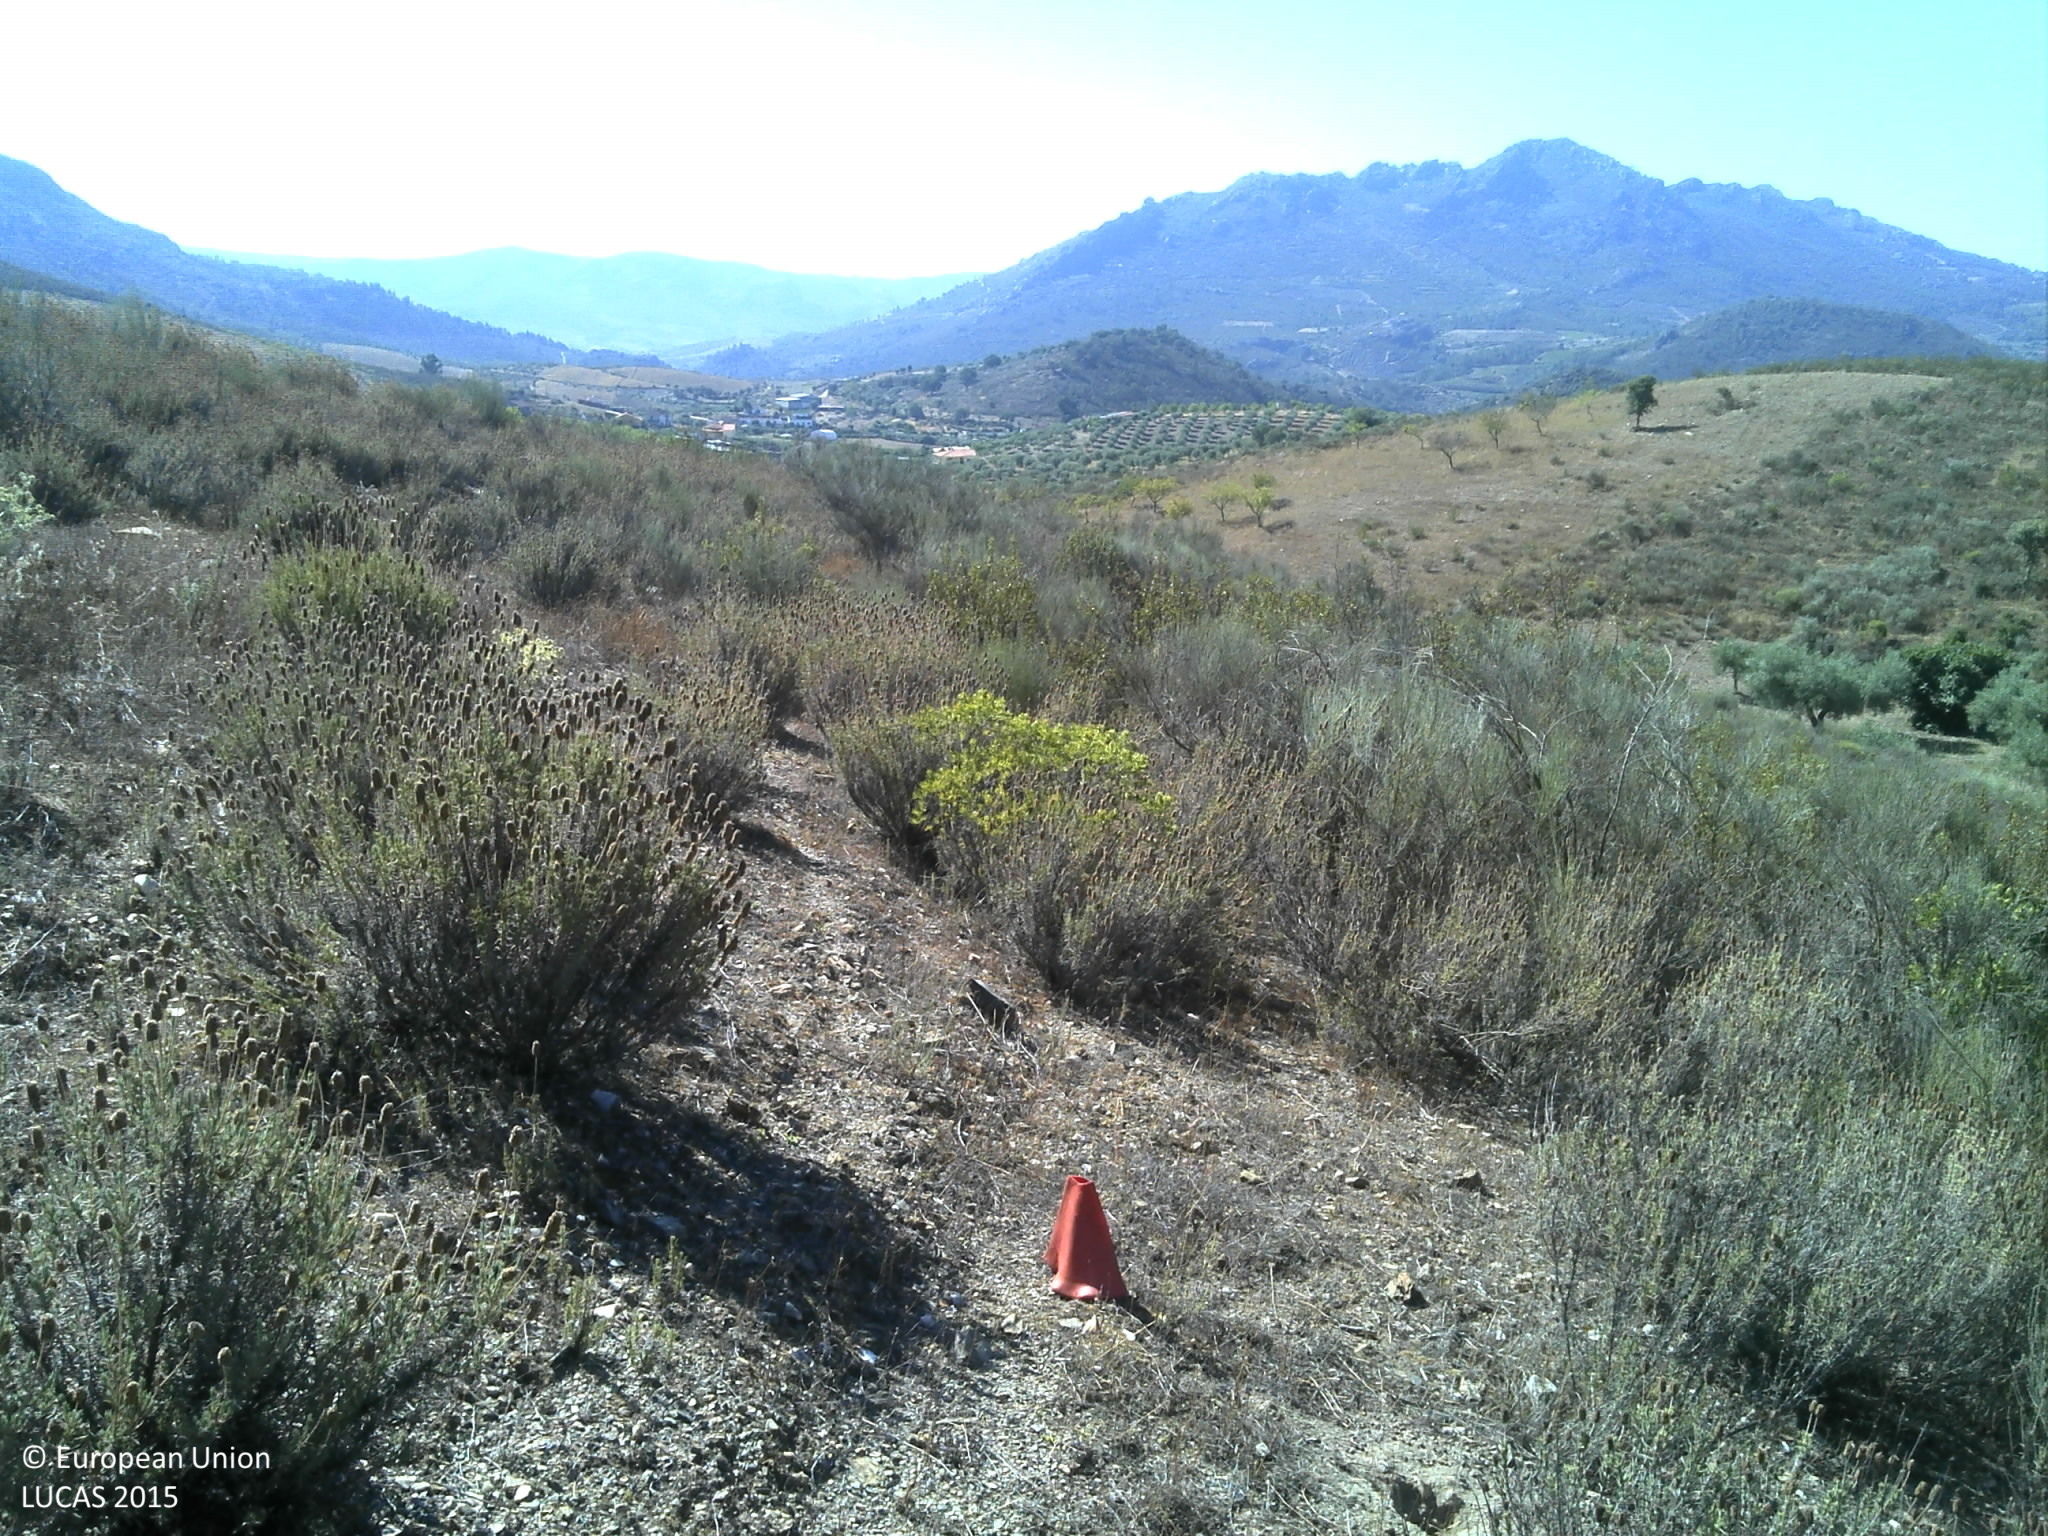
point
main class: Shrubland
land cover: Shrubland without tree cover
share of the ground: 25 - 50 %
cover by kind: shrubs 45 %, unconsolidated bare surface 35 %, herbaceous plants 10 %, consolidated bare surface 10 %
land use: Fallow land
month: July
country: PT
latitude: 41.4069
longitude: -7.2126
